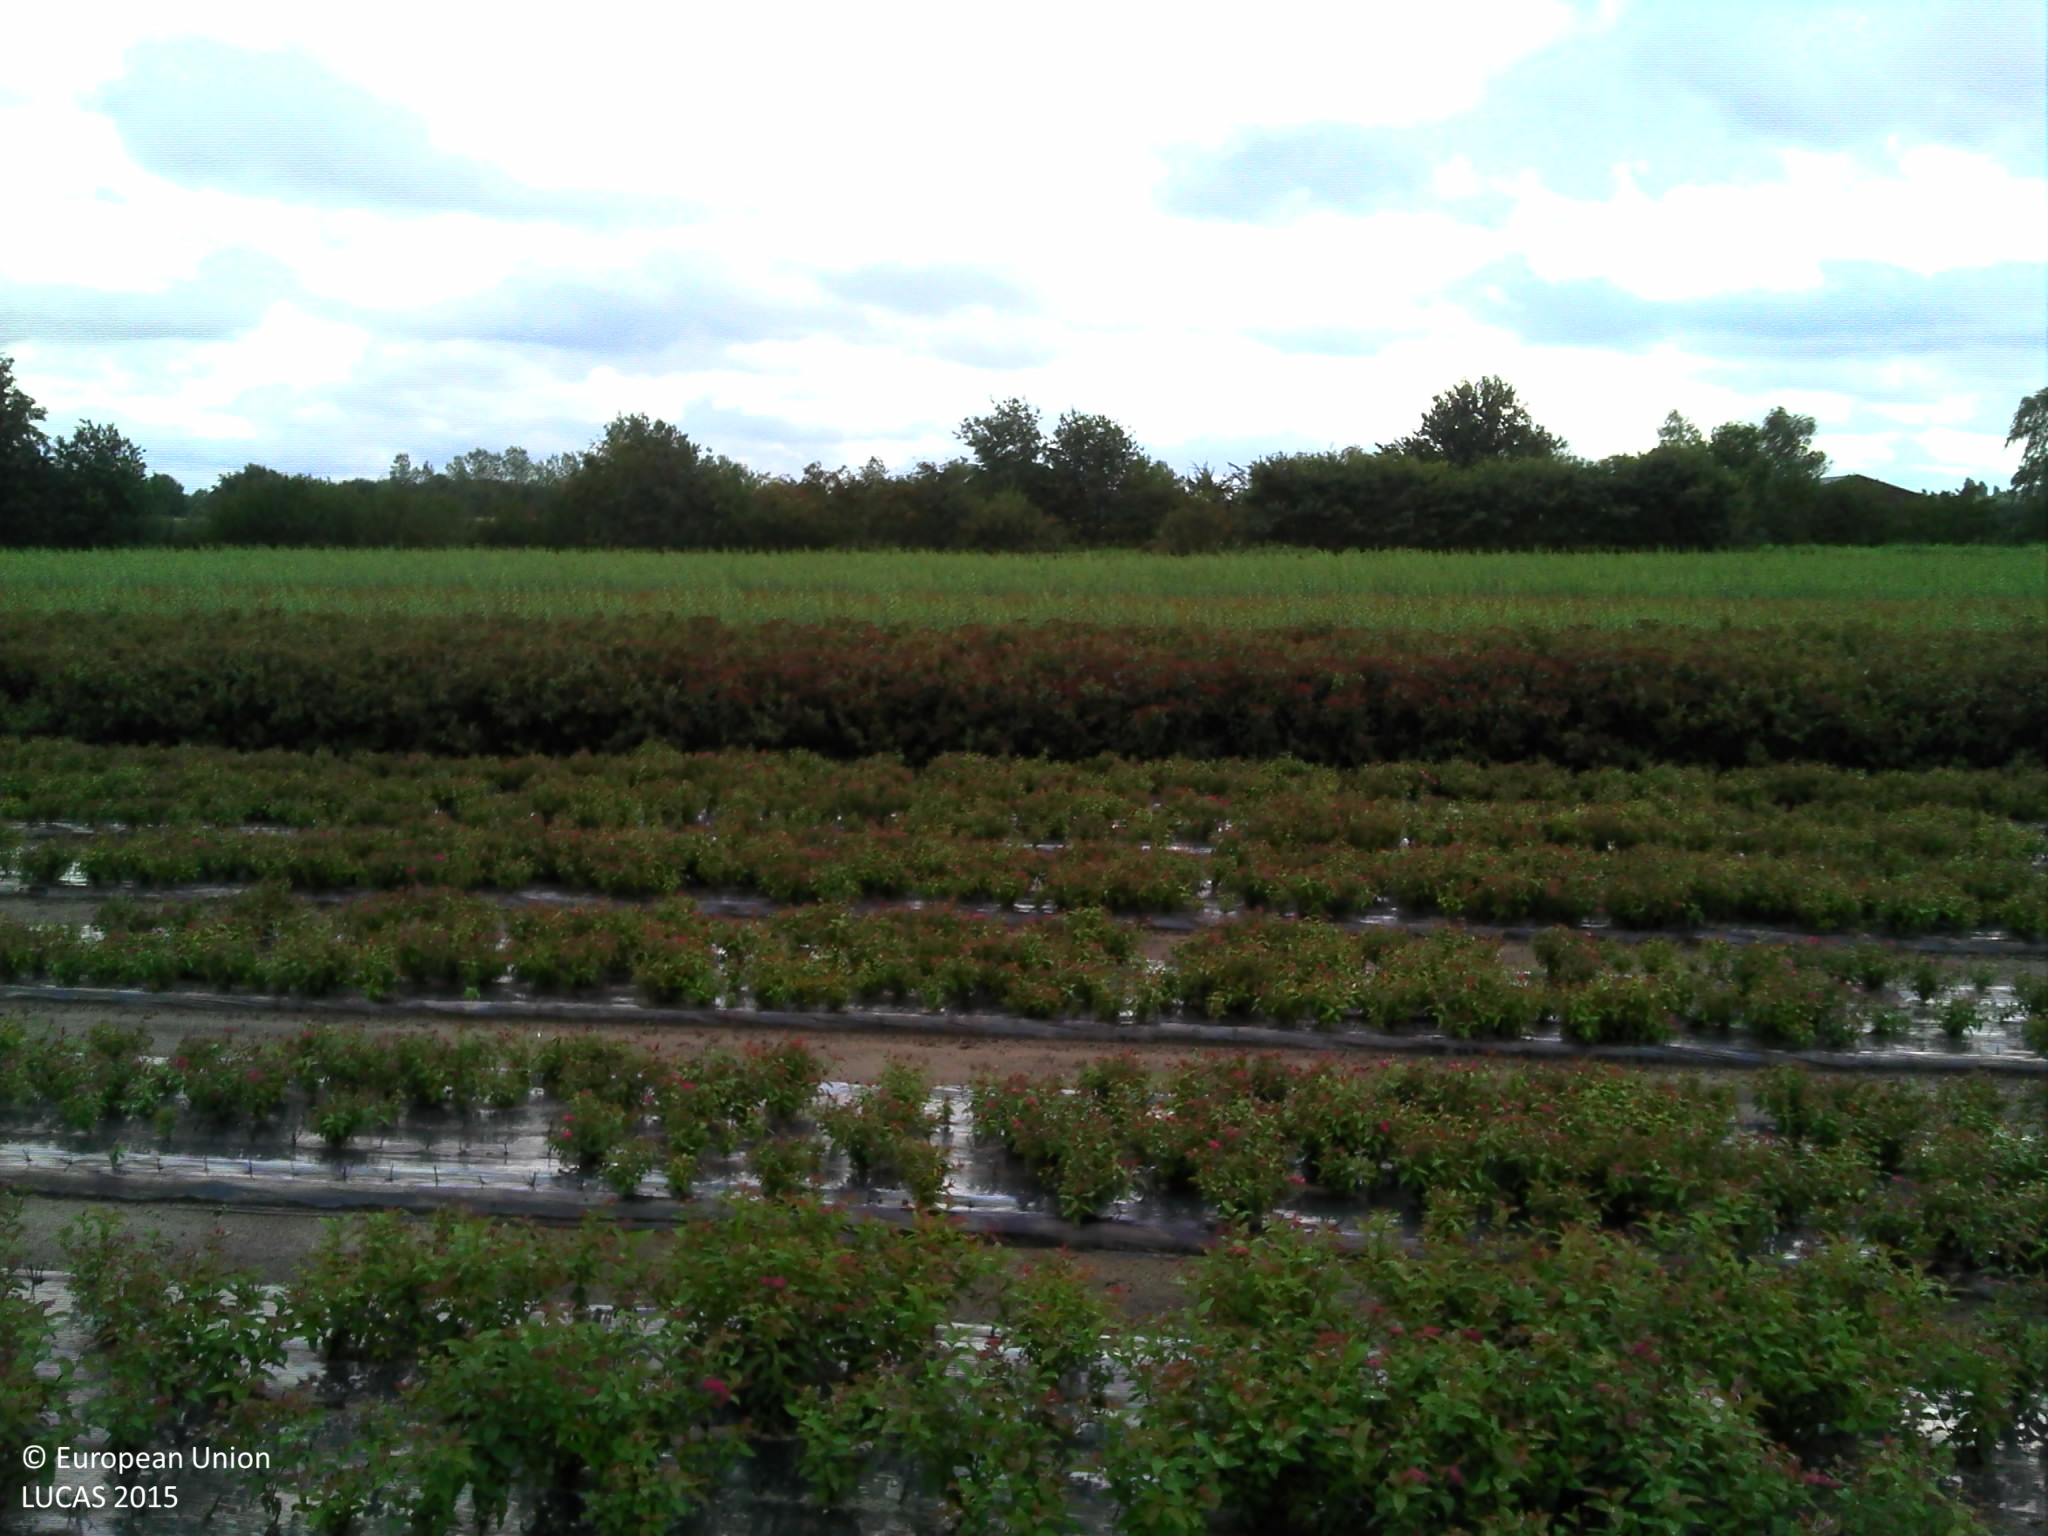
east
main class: Cropland
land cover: Nurseries
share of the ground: 50 - 75 %
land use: Agriculture (excluding fallow land and kitchen gardens)
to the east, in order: Nurseries; Abandoned hedges; Tracks; Abandoned hedges; Ditches and canals; Temporary grasslands; Ditches and canals; Grass margins; Maize
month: September
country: BE
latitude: 51.4517
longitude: 4.7729
